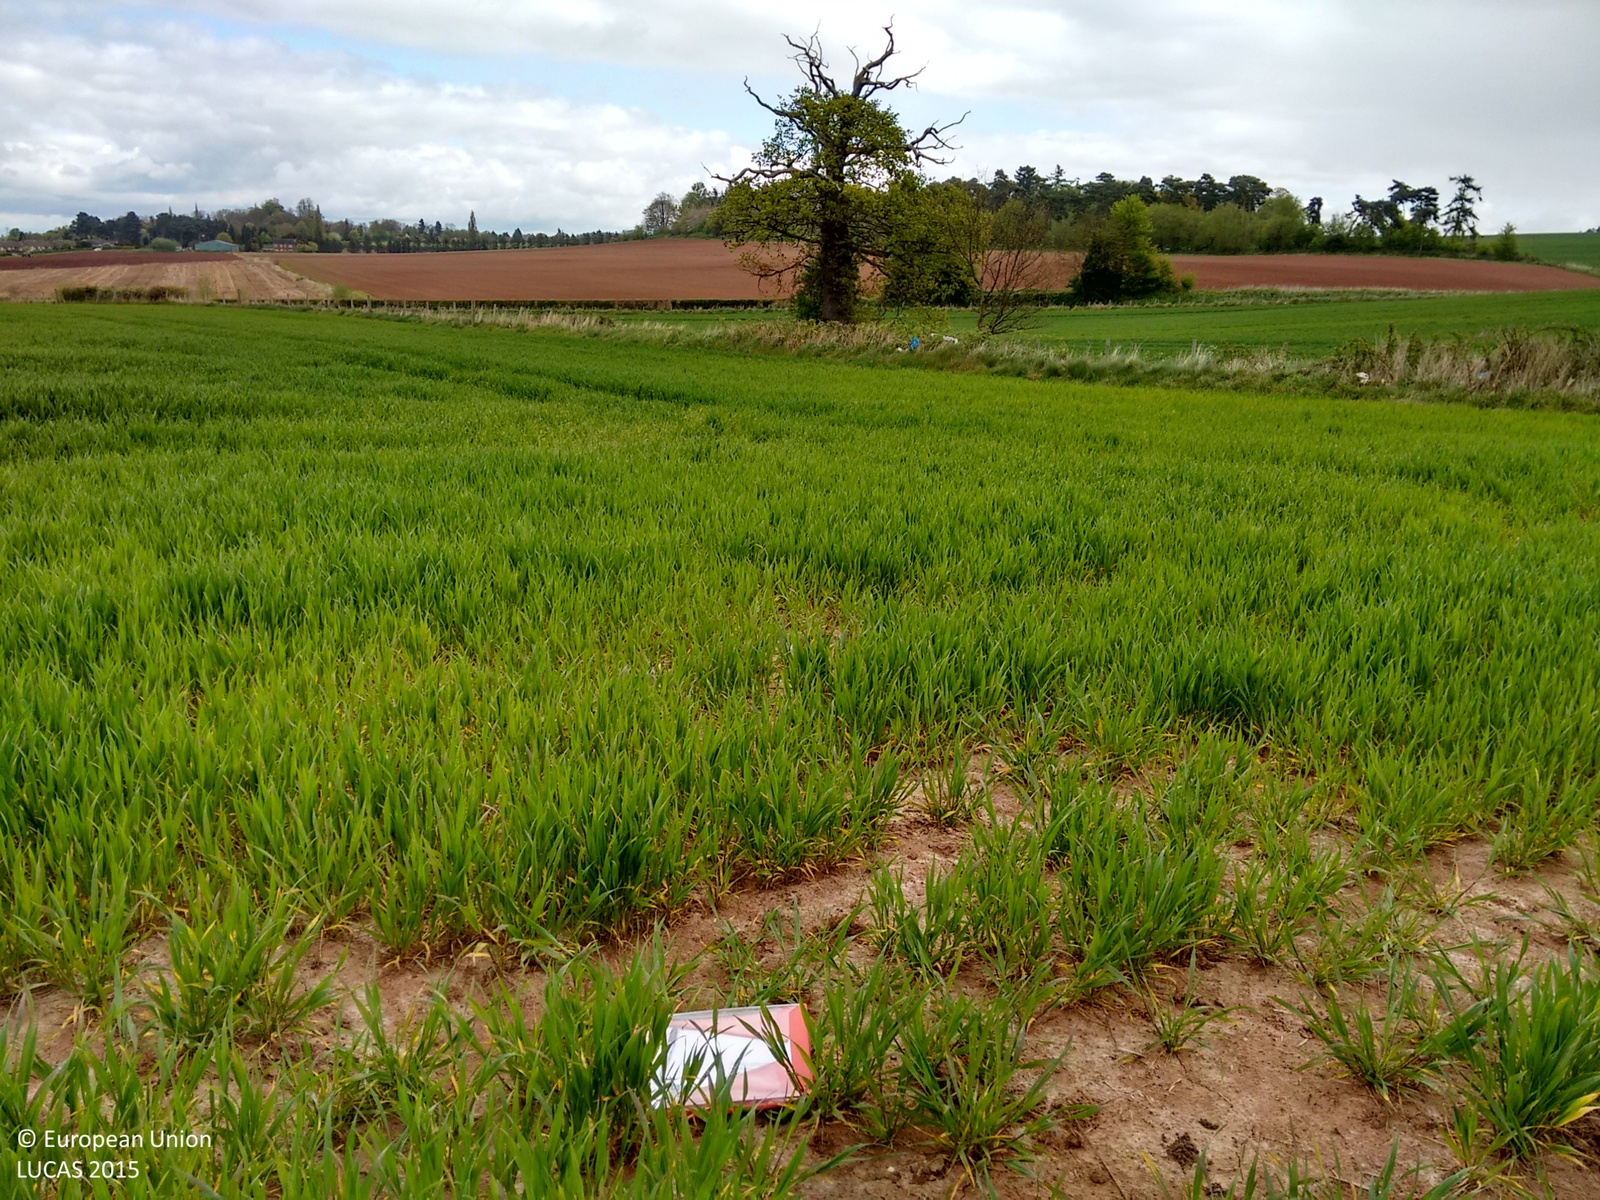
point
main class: Cropland
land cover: Common wheat
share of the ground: 25 - 50 %
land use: Agriculture (excluding fallow land and kitchen gardens)
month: April
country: GB
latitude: 52.3632
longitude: -2.2062
